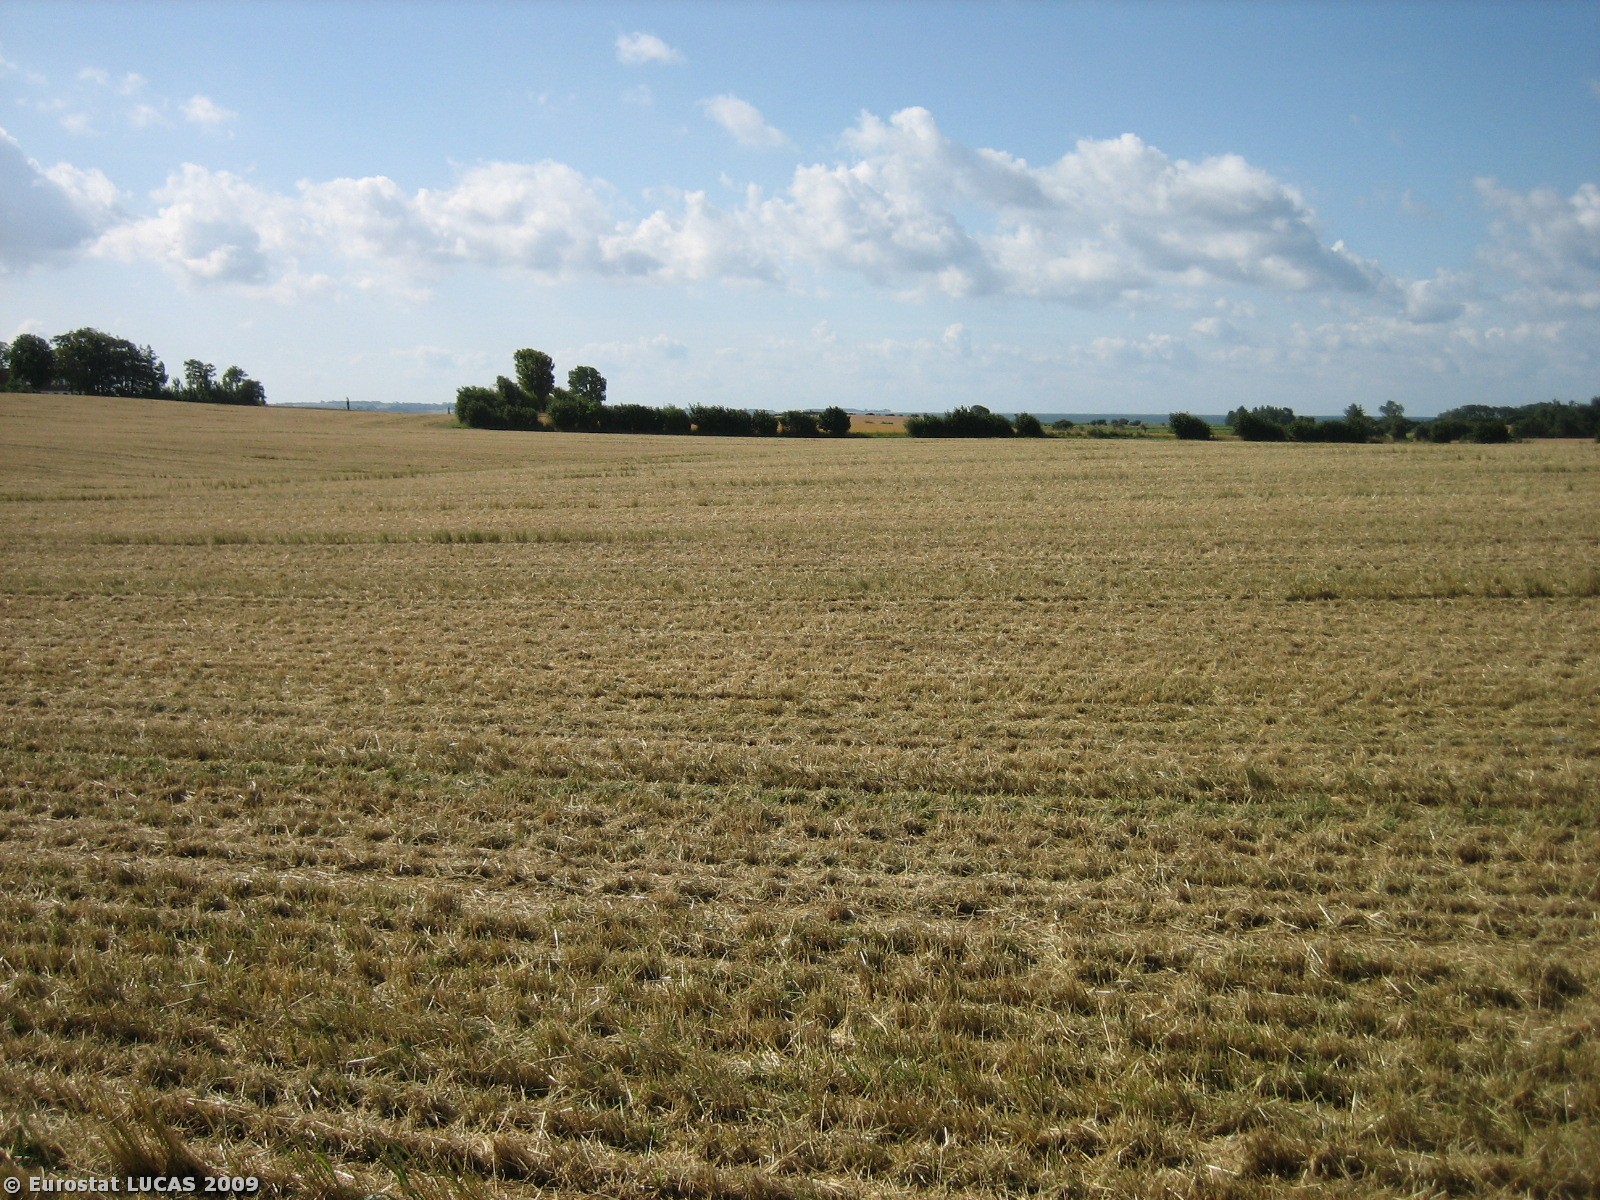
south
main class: Cropland
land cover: Temporary grasslands
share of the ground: > 75 %
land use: Agriculture (excluding fallow land and kitchen gardens)
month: July
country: DK
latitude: 55.3608
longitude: 9.8582
